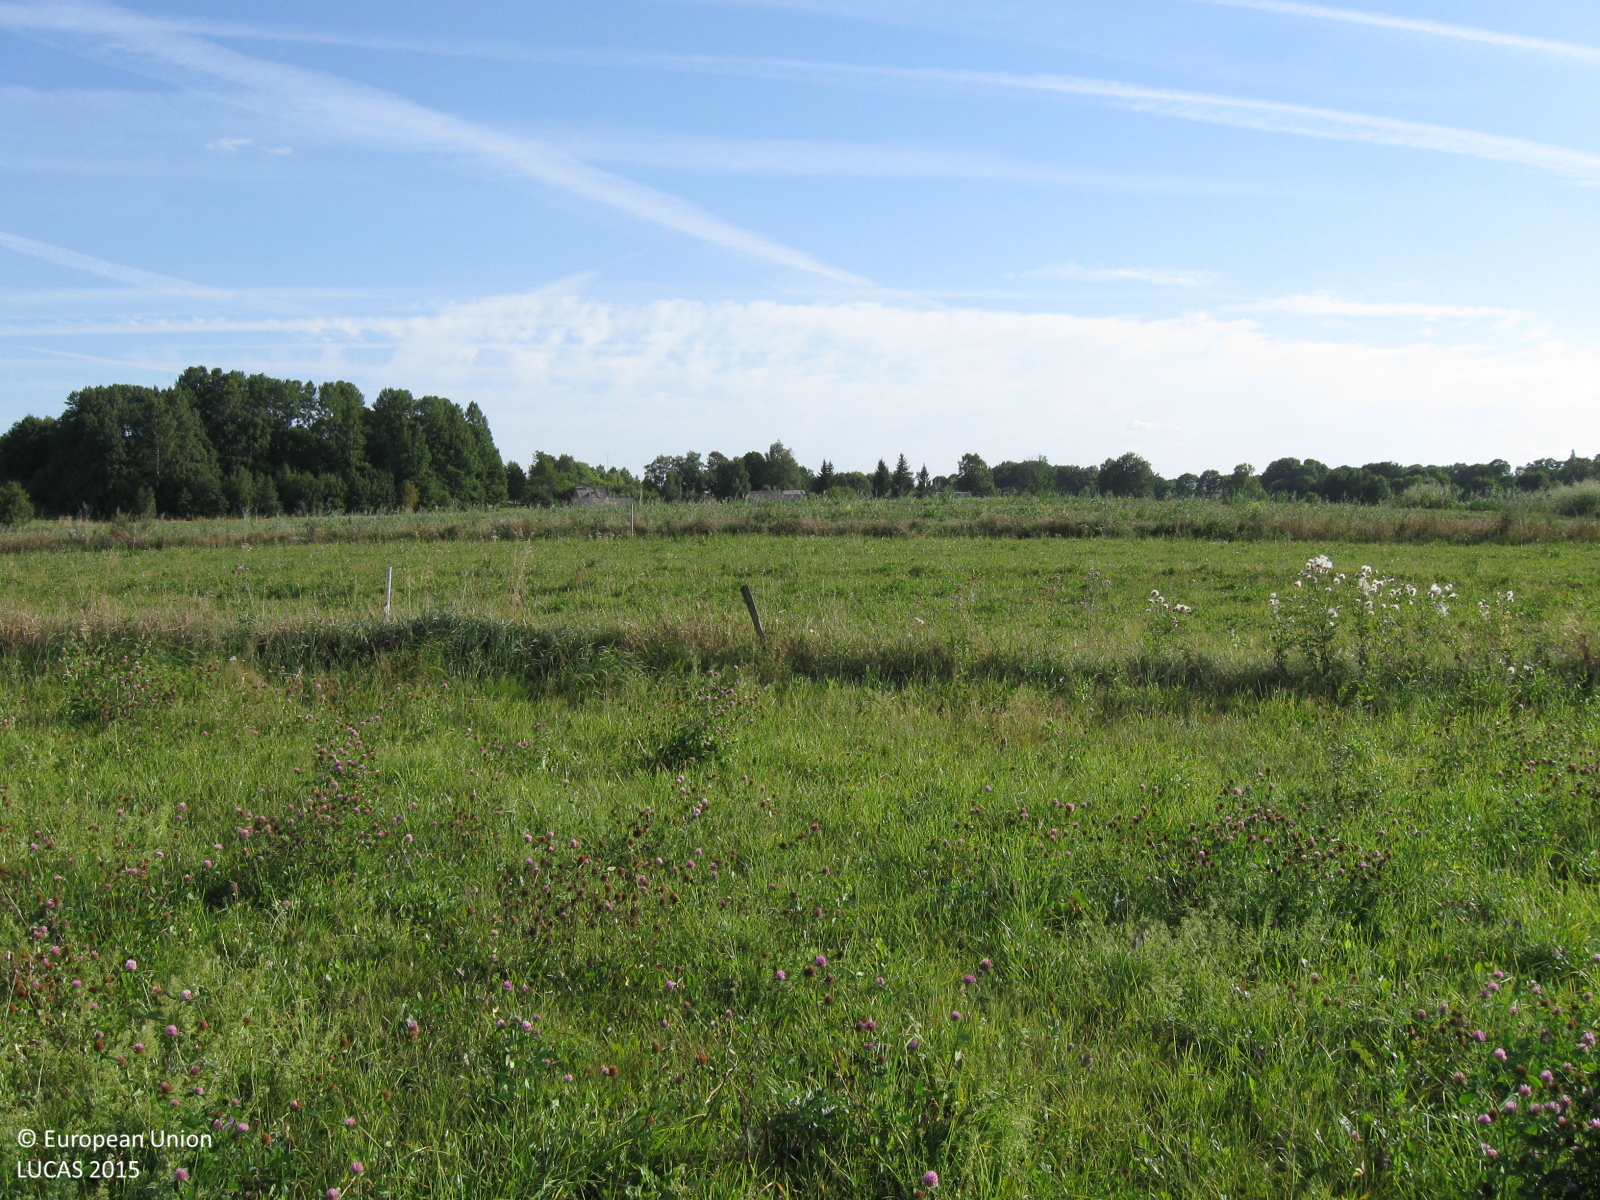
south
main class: Grassland
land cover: Grassland without tree/shrub cover
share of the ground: > 75 %
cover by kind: herbaceous plants 100 %
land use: Agriculture (excluding fallow land and kitchen gardens)
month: August
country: LT
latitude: 55.4748
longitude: 22.5765
